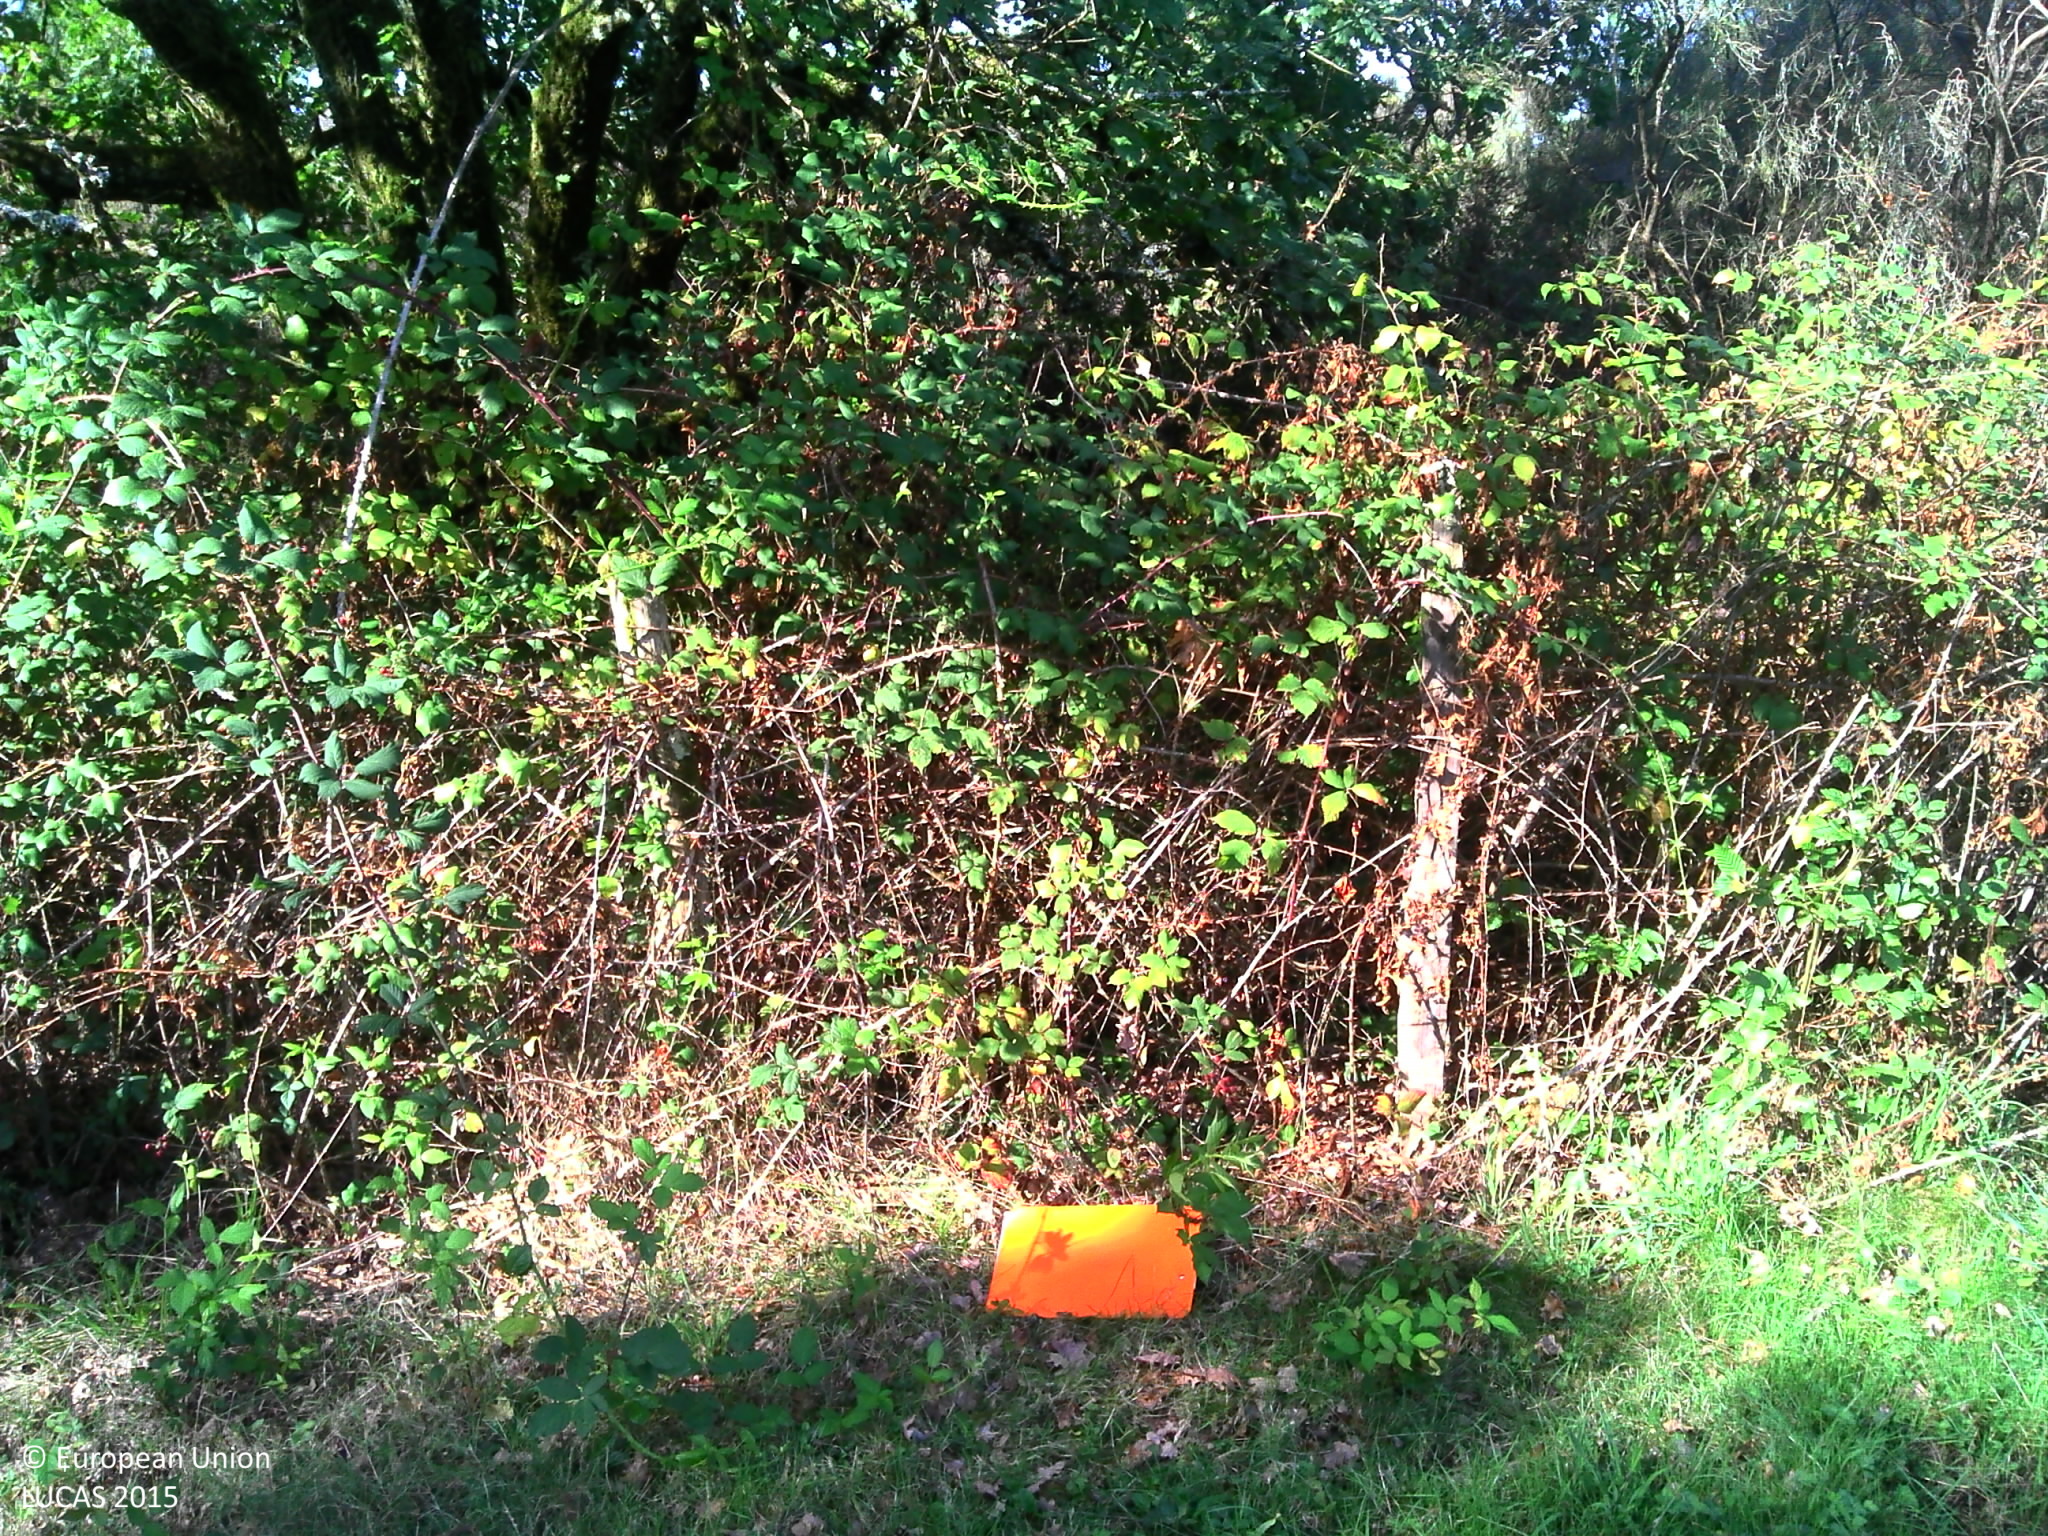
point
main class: Grassland
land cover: Spontaneously vegetated surfaces
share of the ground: > 75 %
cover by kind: herbaceous plants 60 %, unconsolidated bare surface 25 %, lichens and mosses 10 %, shrubs 5 %
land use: Semi-natural and natural areas not in use
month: August
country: FR
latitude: 45.4149
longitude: 0.6475
